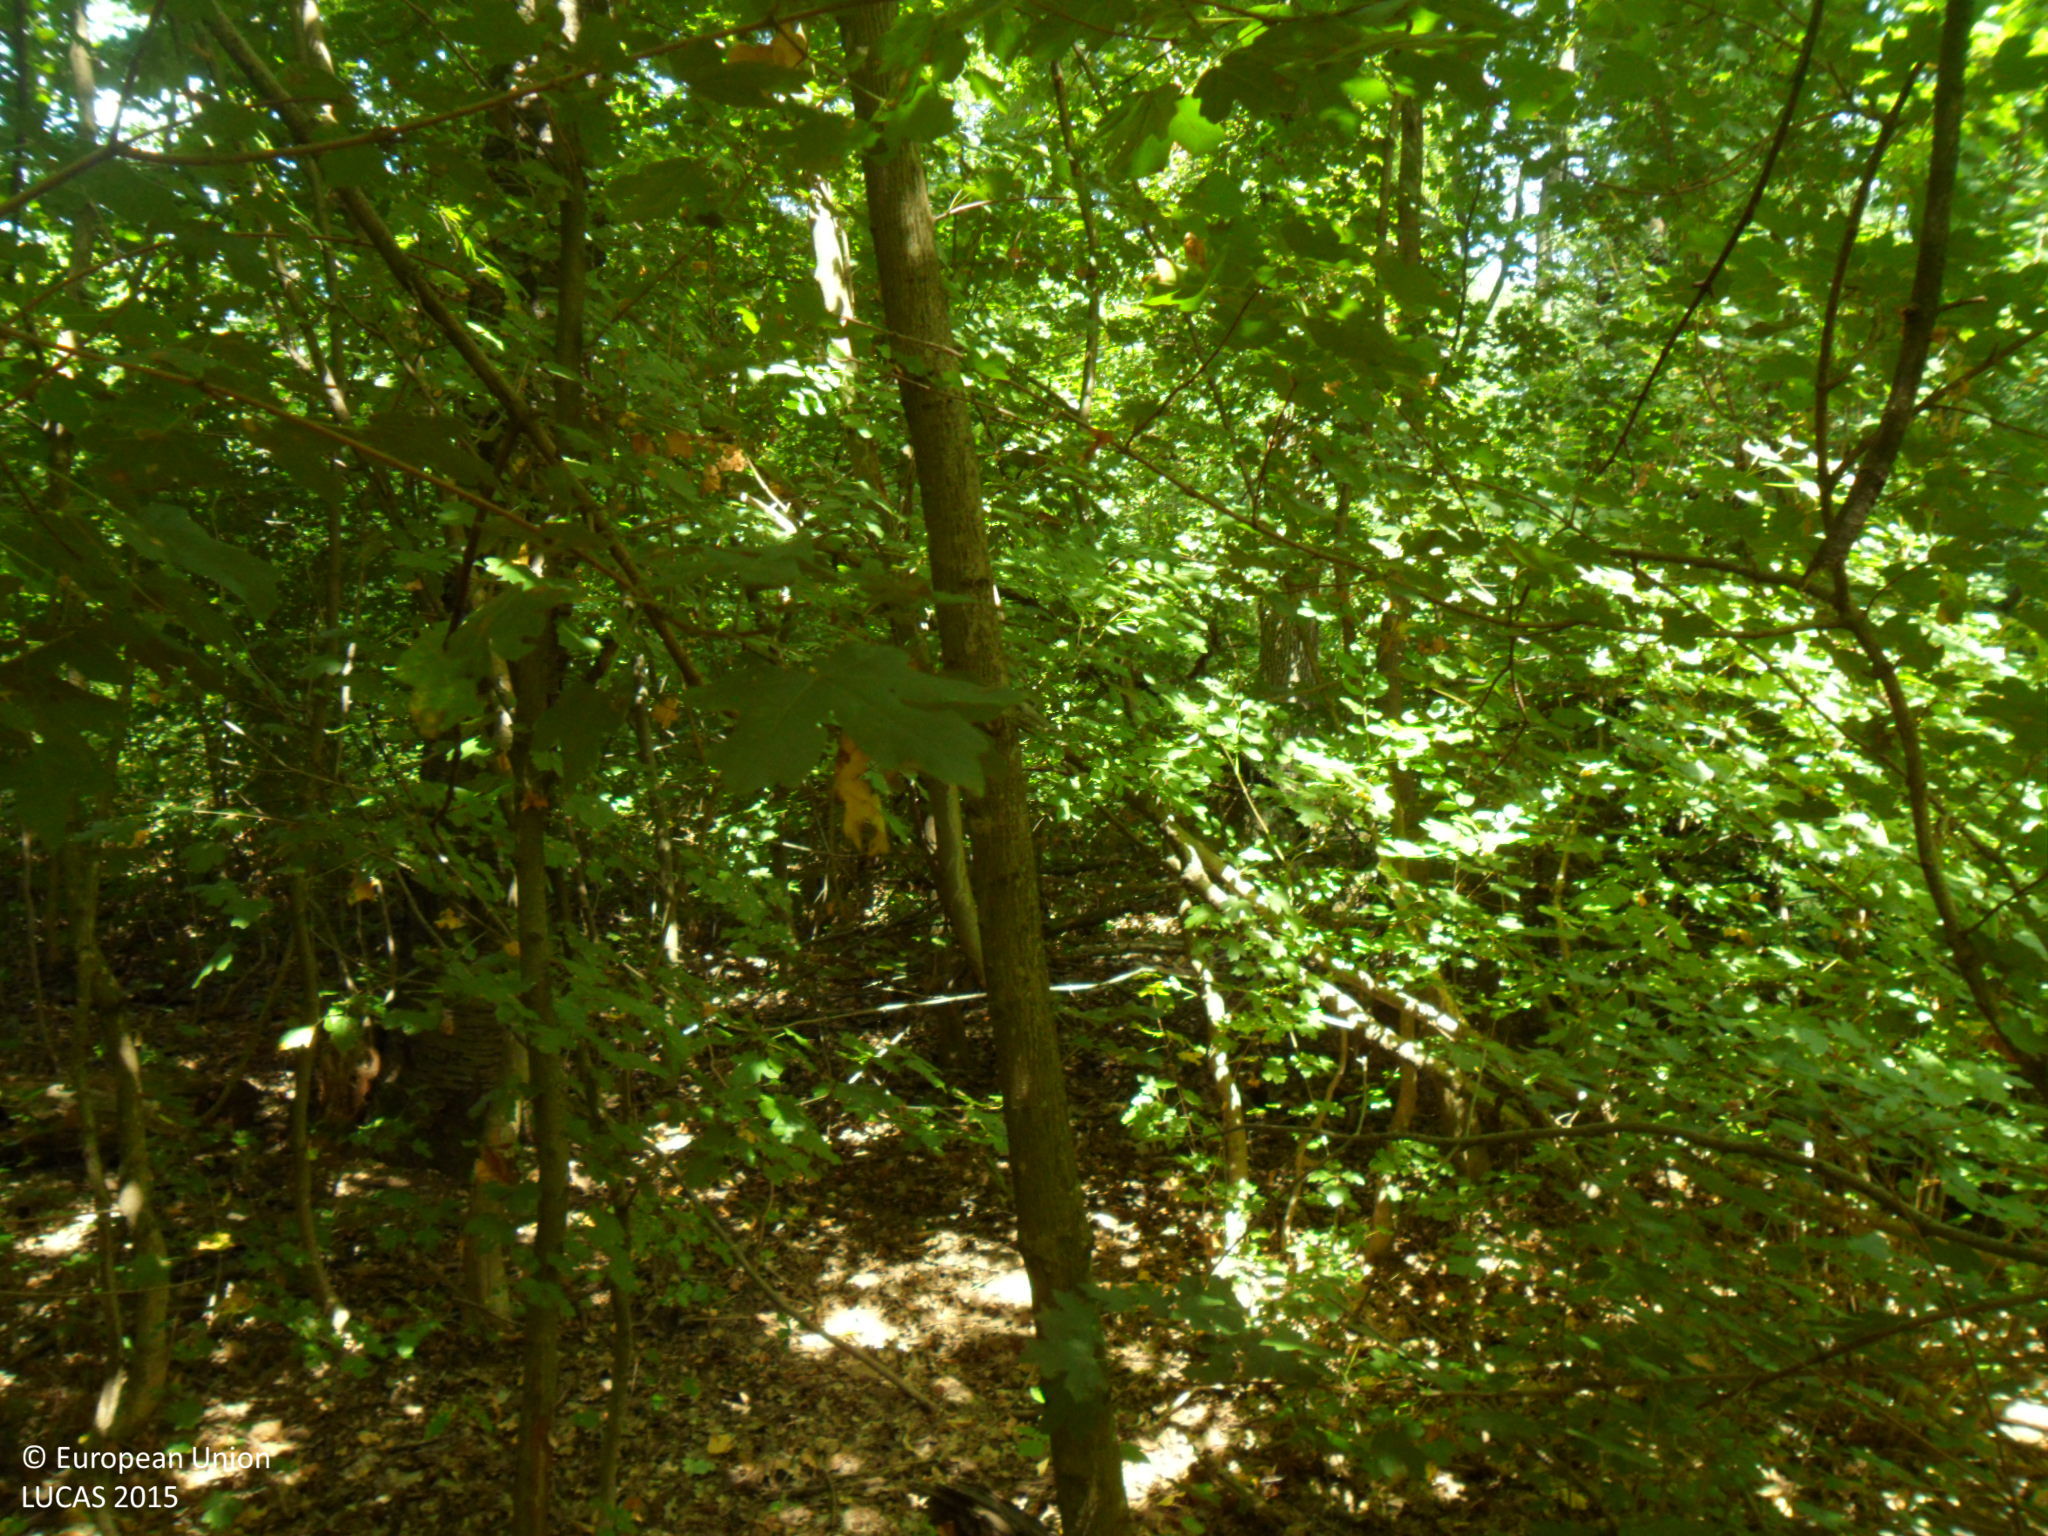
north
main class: Woodland
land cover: Broadleaved woodland
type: mesophytic deciduous forest
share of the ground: > 75 %
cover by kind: broadleaved forest trees 100 %
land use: Forestry
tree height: > 5 m
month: August
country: BG
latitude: 43.5580
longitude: 26.6859
